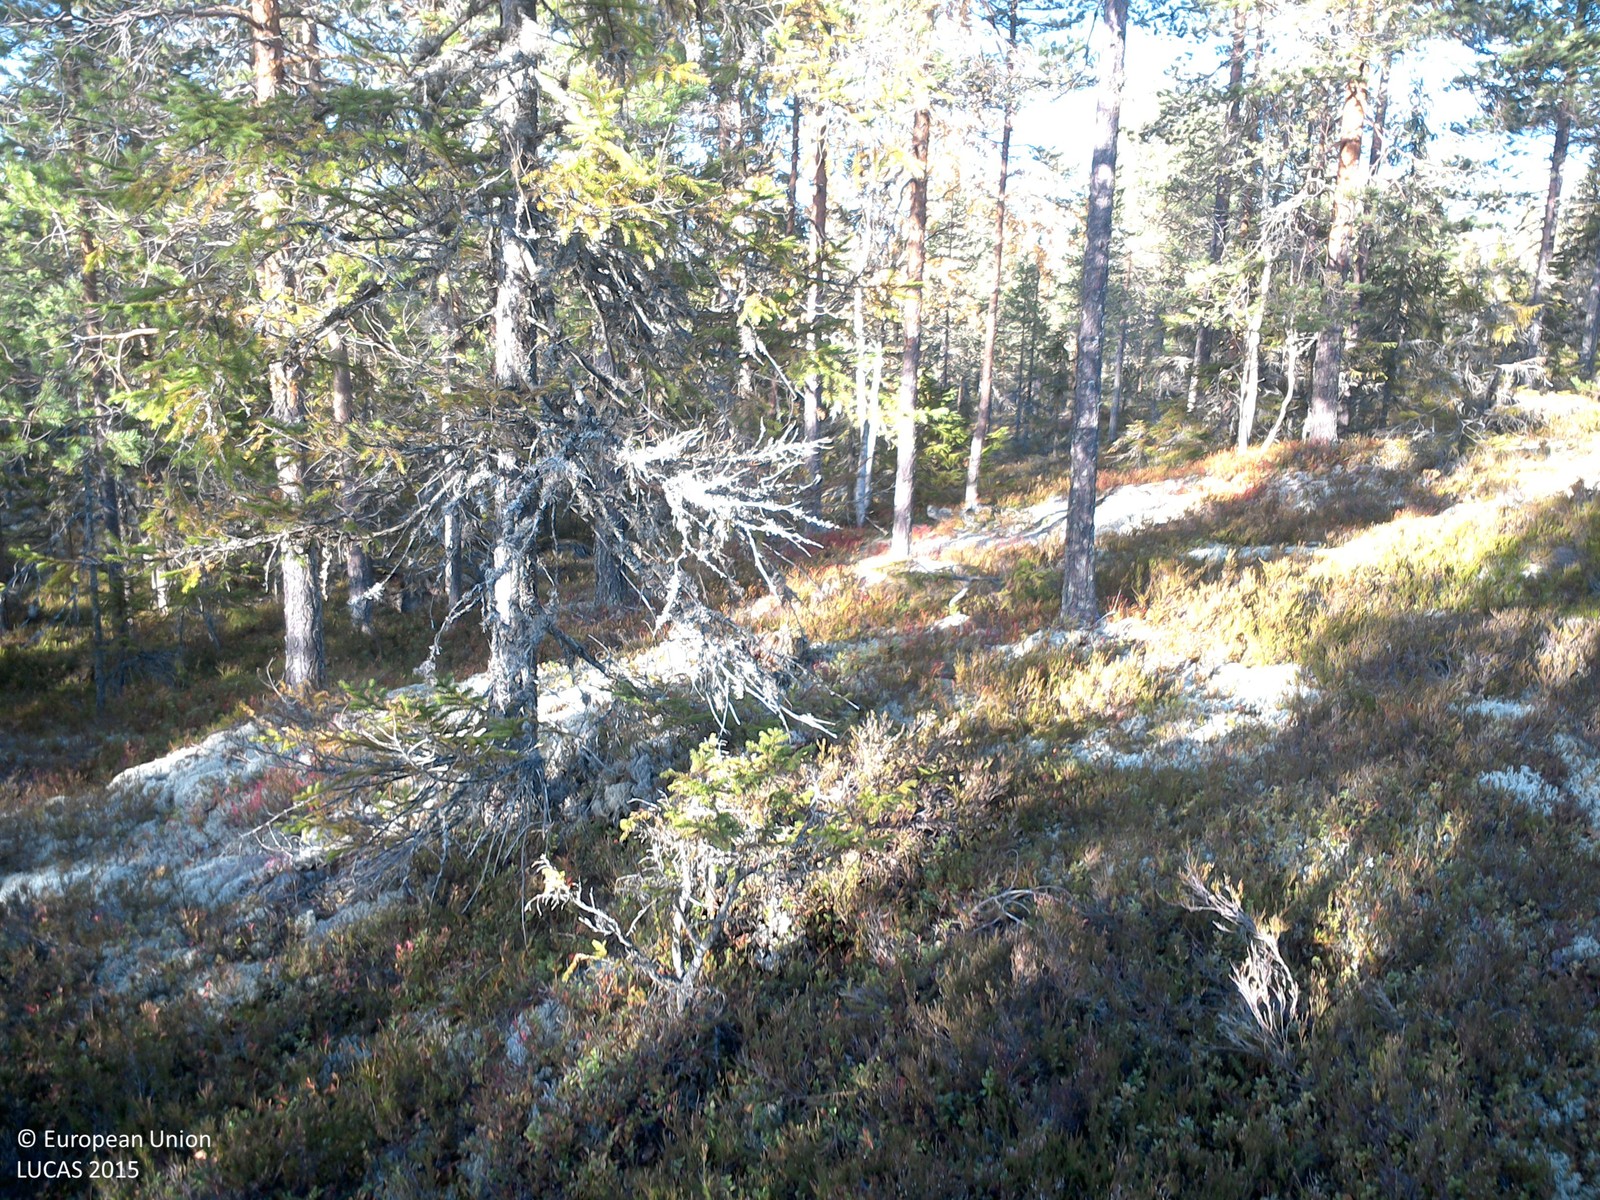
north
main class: Woodland
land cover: Other coniferous woodland
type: boreal forest
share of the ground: 50 - 75 %
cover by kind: coniferous forest trees 50 %, shrubs 50 %
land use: Forestry
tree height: > 5 m
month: October
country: SE
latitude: 63.8829
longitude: 19.9766
